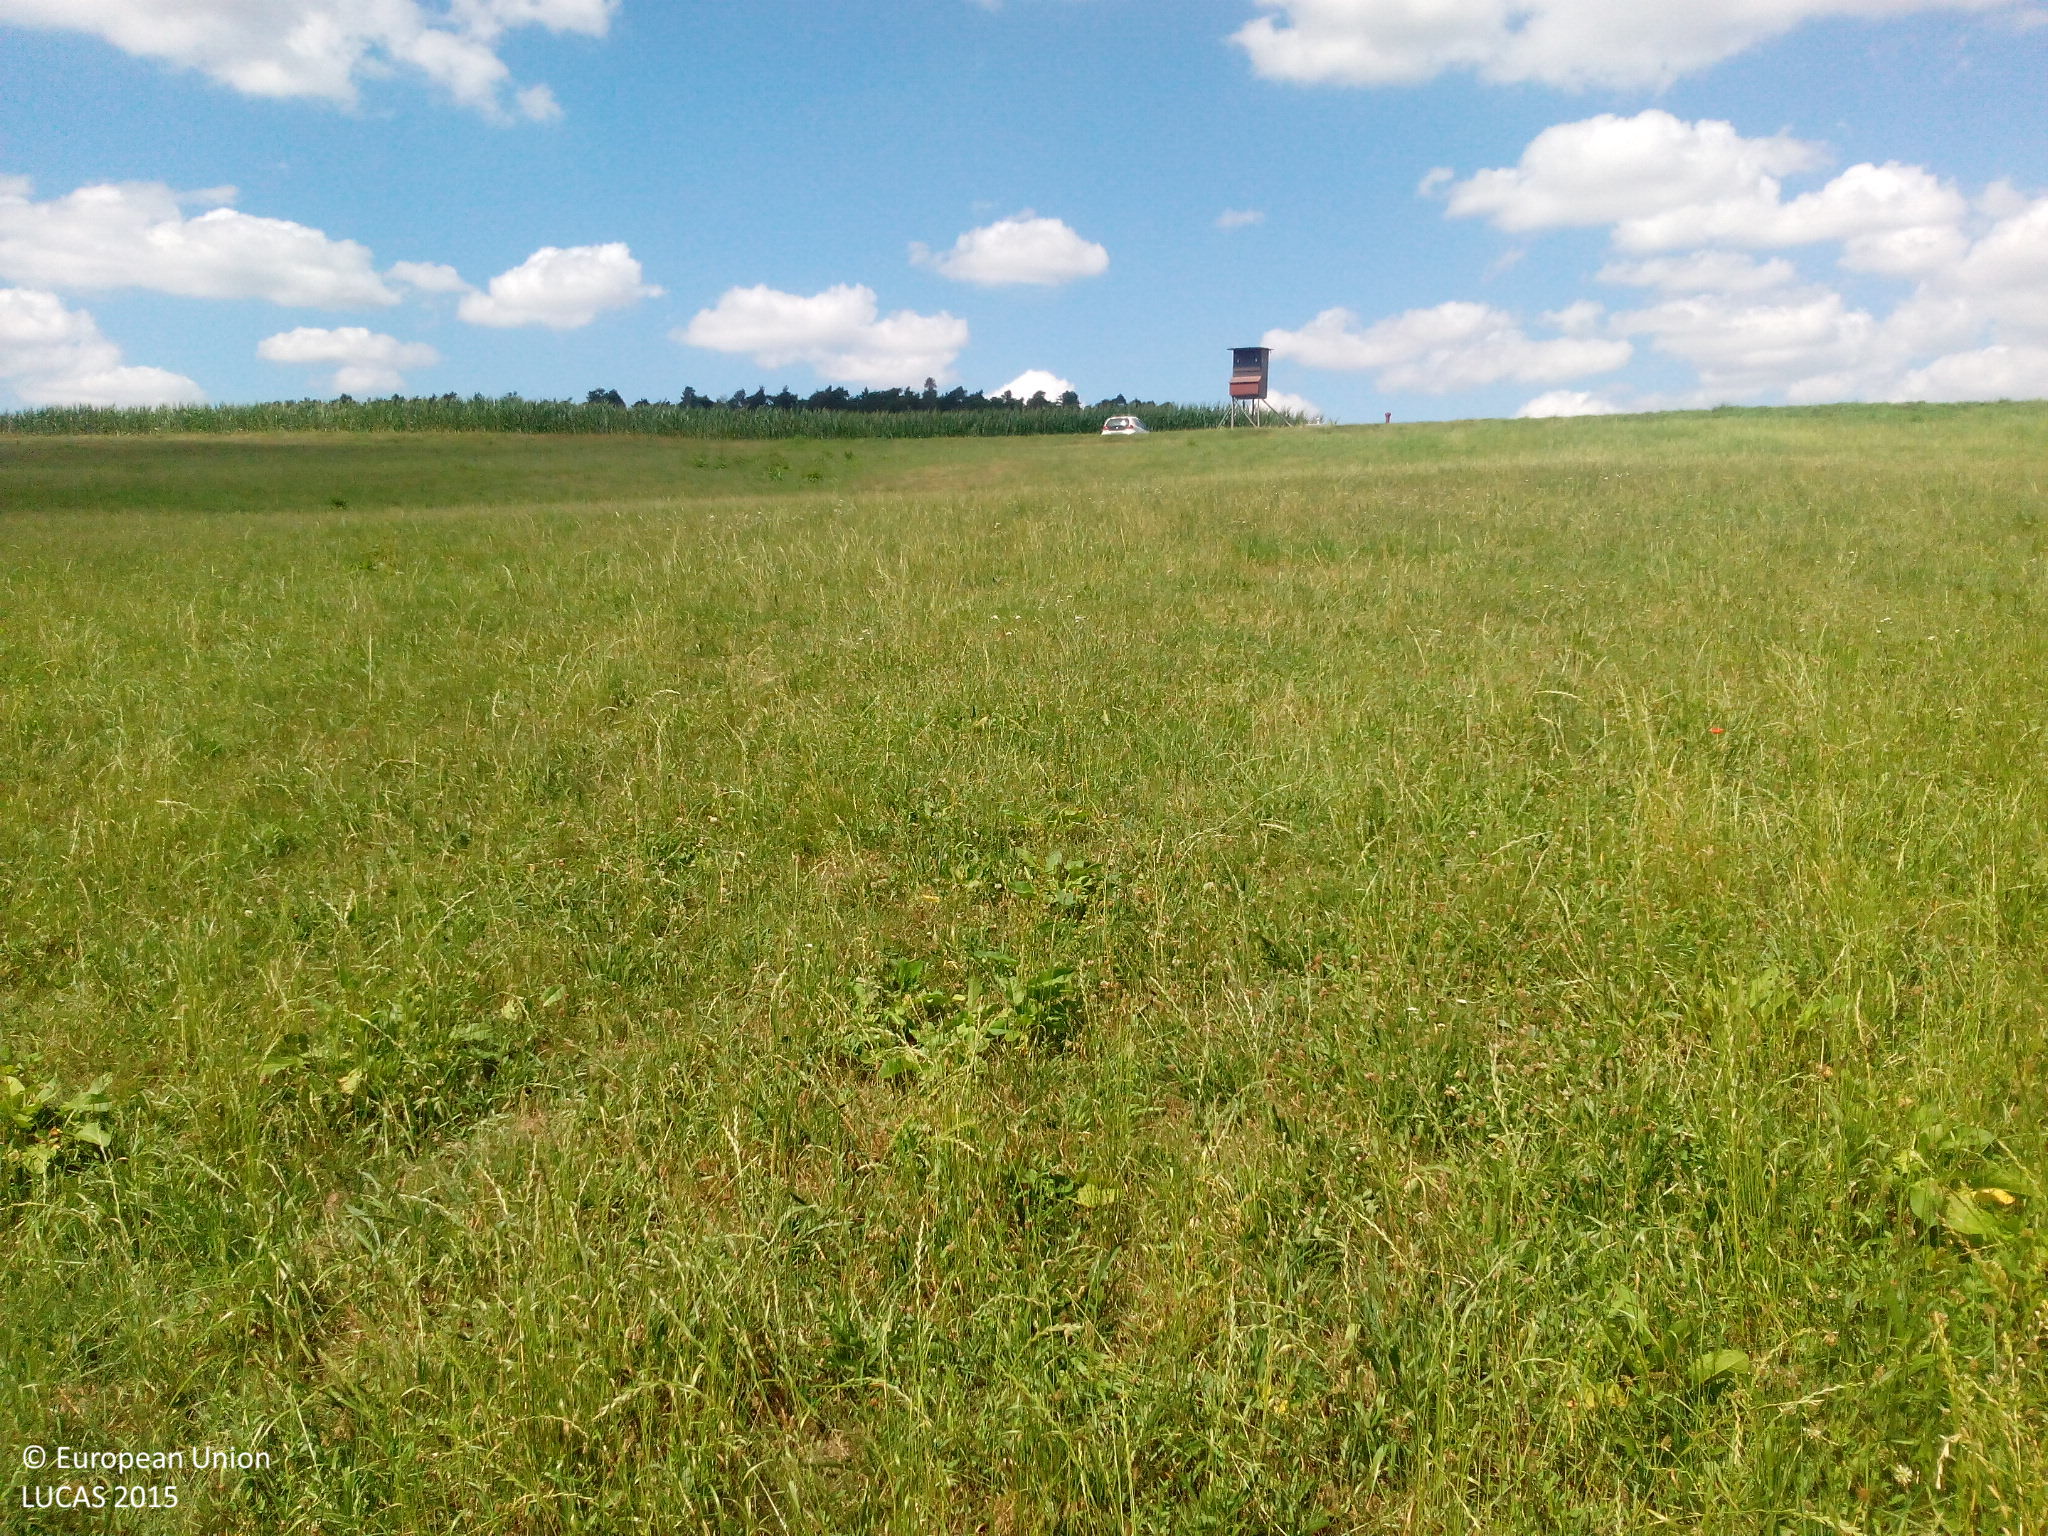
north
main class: Grassland
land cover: Grassland without tree/shrub cover
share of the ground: > 75 %
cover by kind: herbaceous plants 100 %
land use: Agriculture (excluding fallow land and kitchen gardens)
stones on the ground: < 10 %
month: July
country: DE
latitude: 49.4433
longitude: 10.8962
